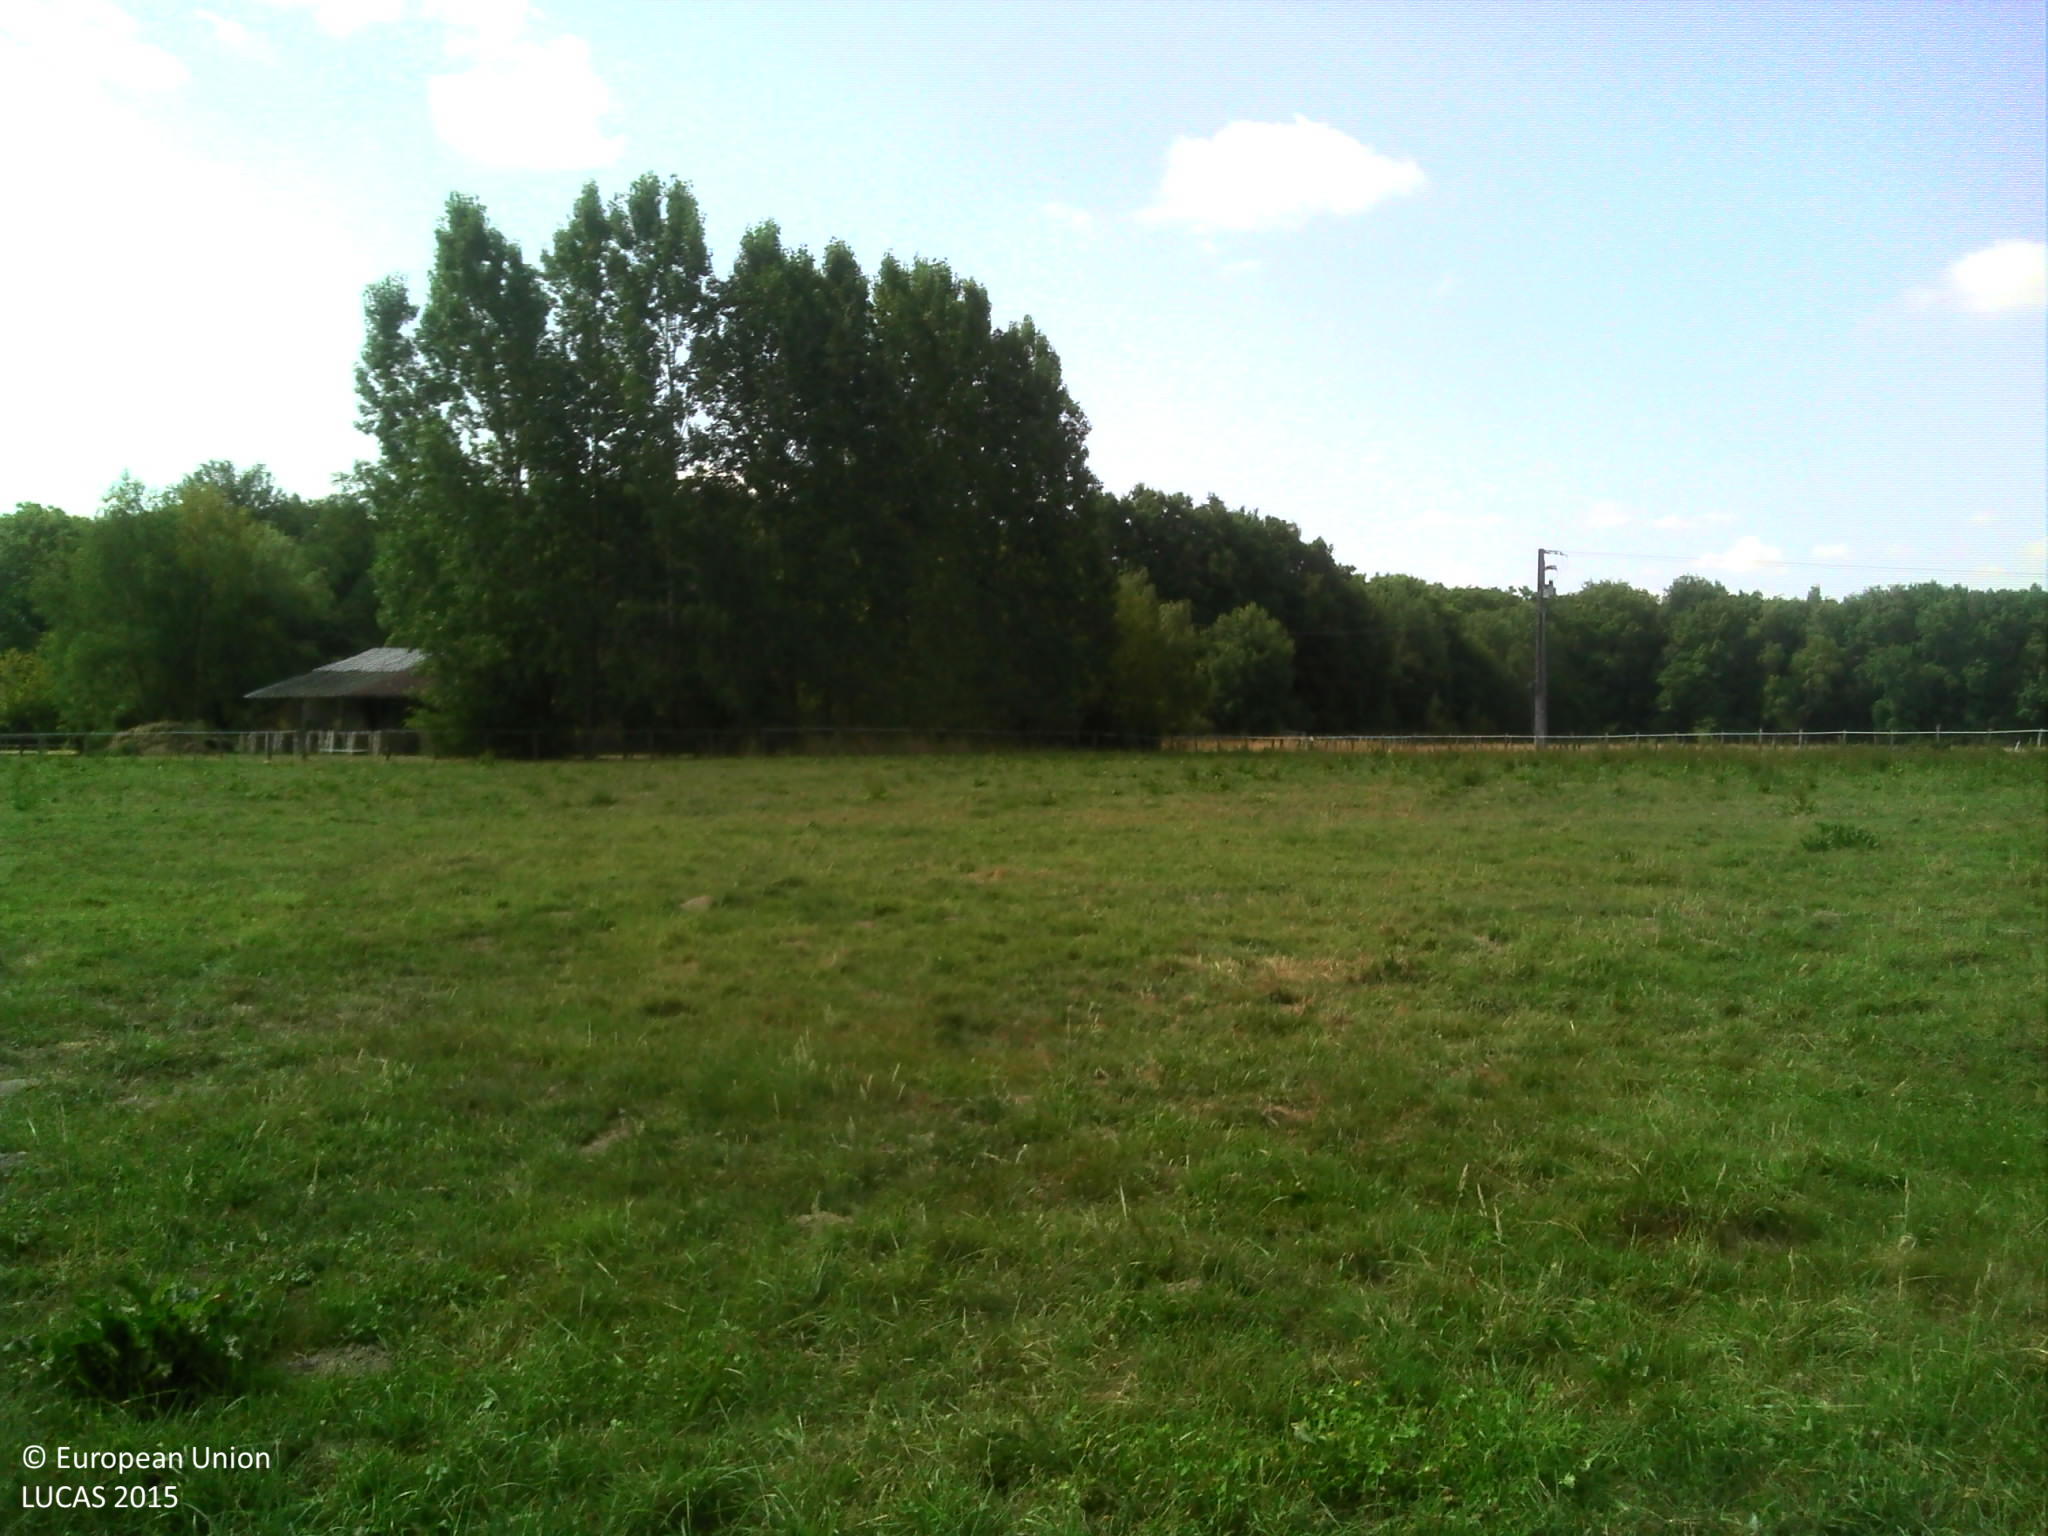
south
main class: Grassland
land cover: Grassland without tree/shrub cover
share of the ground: > 75 %
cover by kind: herbaceous plants 100 %
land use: Agriculture (excluding fallow land and kitchen gardens)
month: July
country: FR
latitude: 46.8887
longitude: 5.1062
